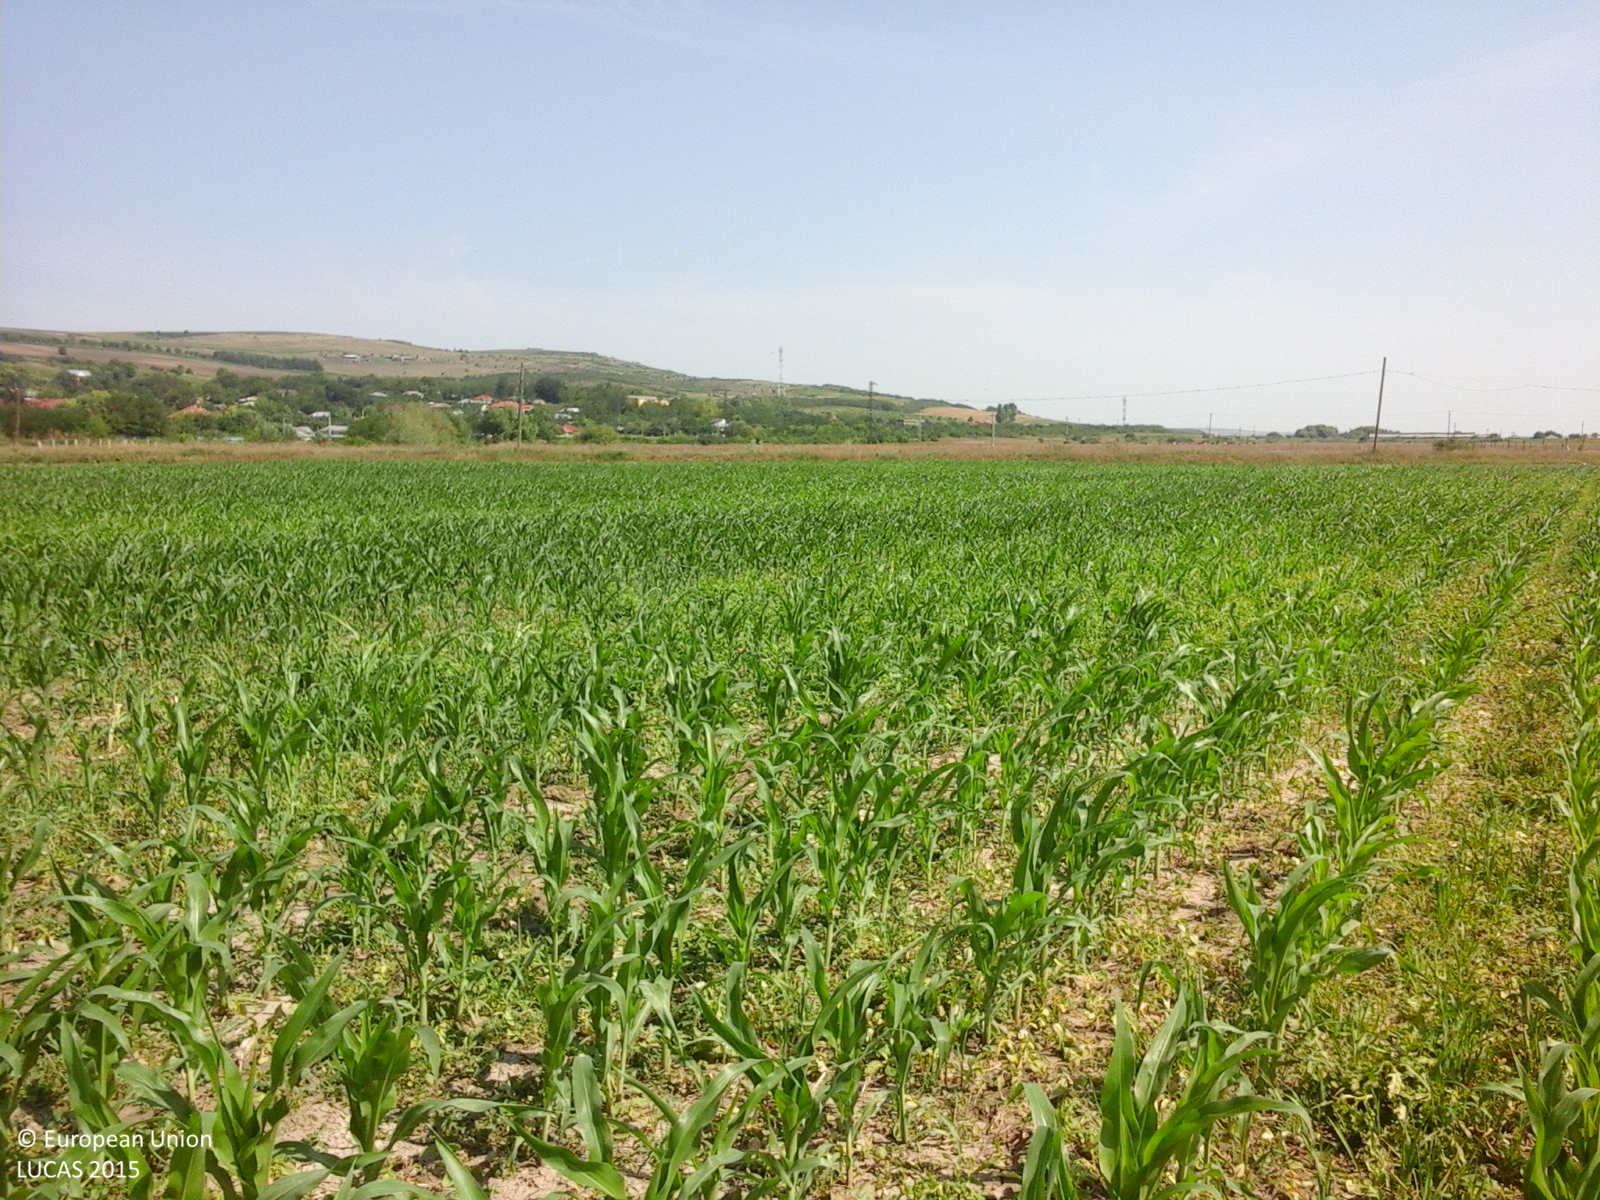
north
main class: Cropland
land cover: Maize
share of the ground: 50 - 75 %
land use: Agriculture (excluding fallow land and kitchen gardens)
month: July
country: RO
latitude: 46.1168
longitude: 27.5652
